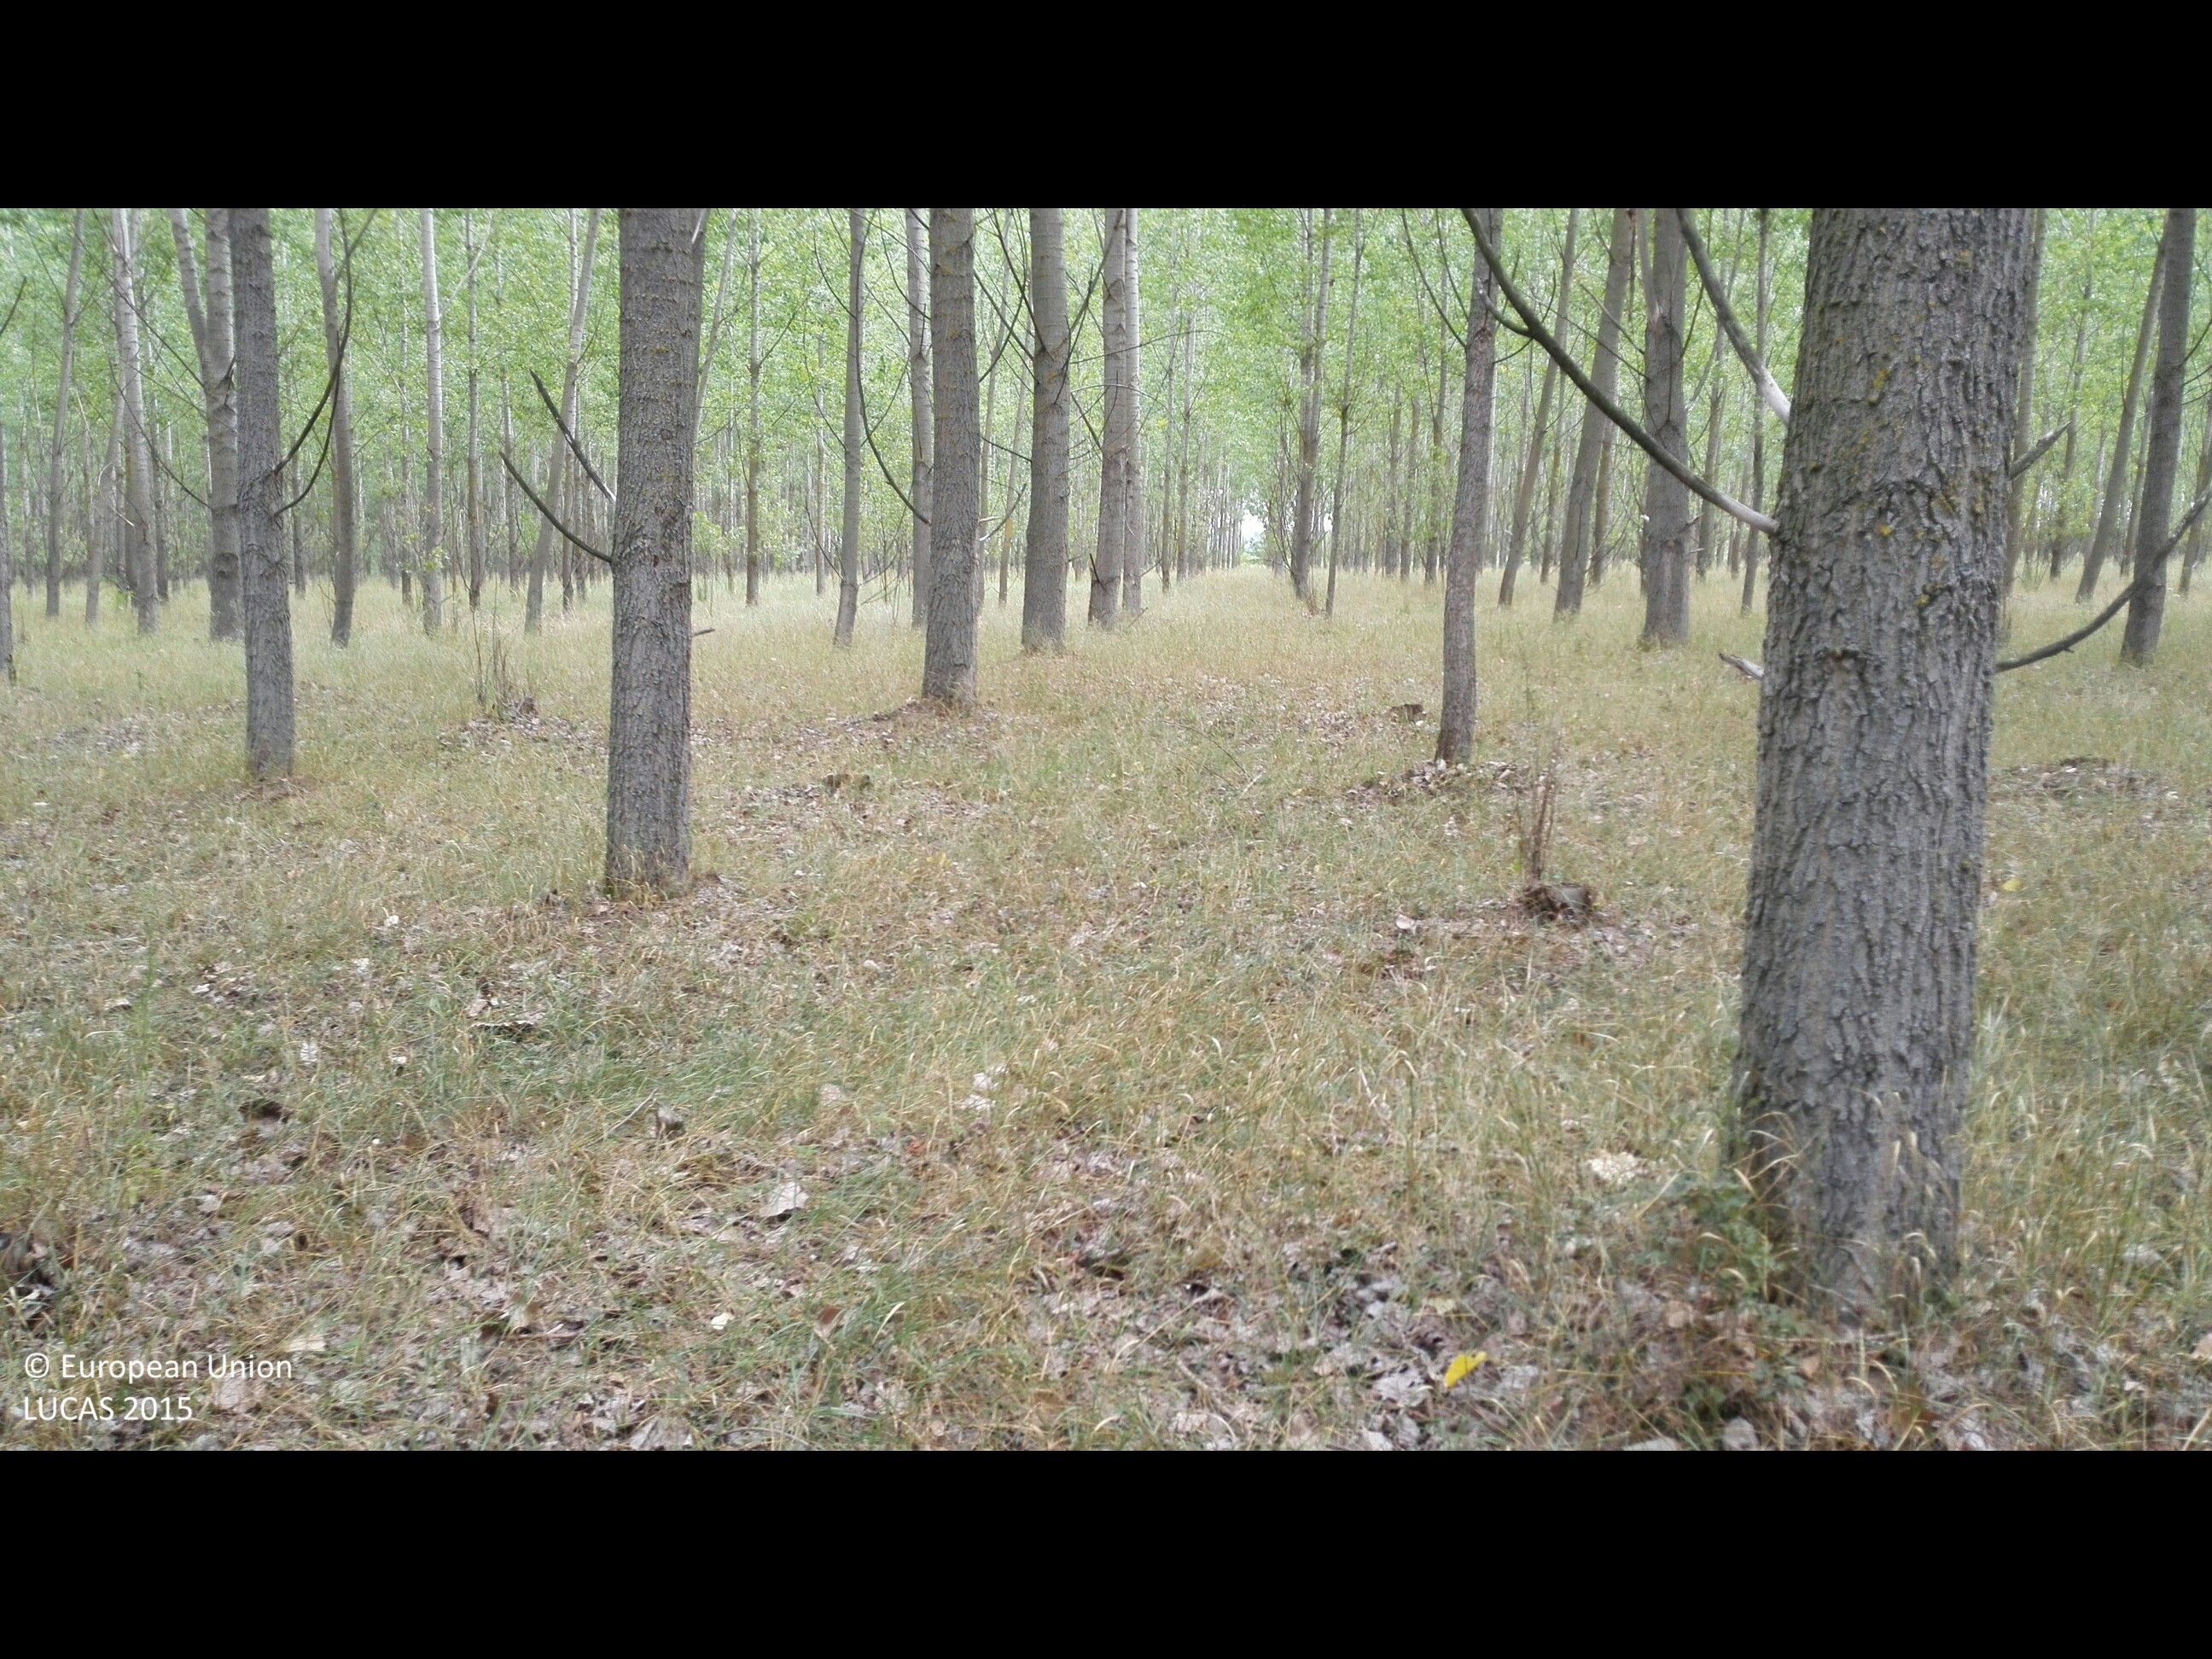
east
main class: Woodland
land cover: Broadleaved woodland
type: non-riverine alder, birch or aspen forest
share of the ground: > 75 %
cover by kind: broadleaved forest trees 90 %, herbaceous plants 10 %
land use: Forestry
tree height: > 5 m
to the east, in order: Broadleaved woodland; Tracks; Broadleaved woodland
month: August
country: HU
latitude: 47.5415
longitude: 21.8857
